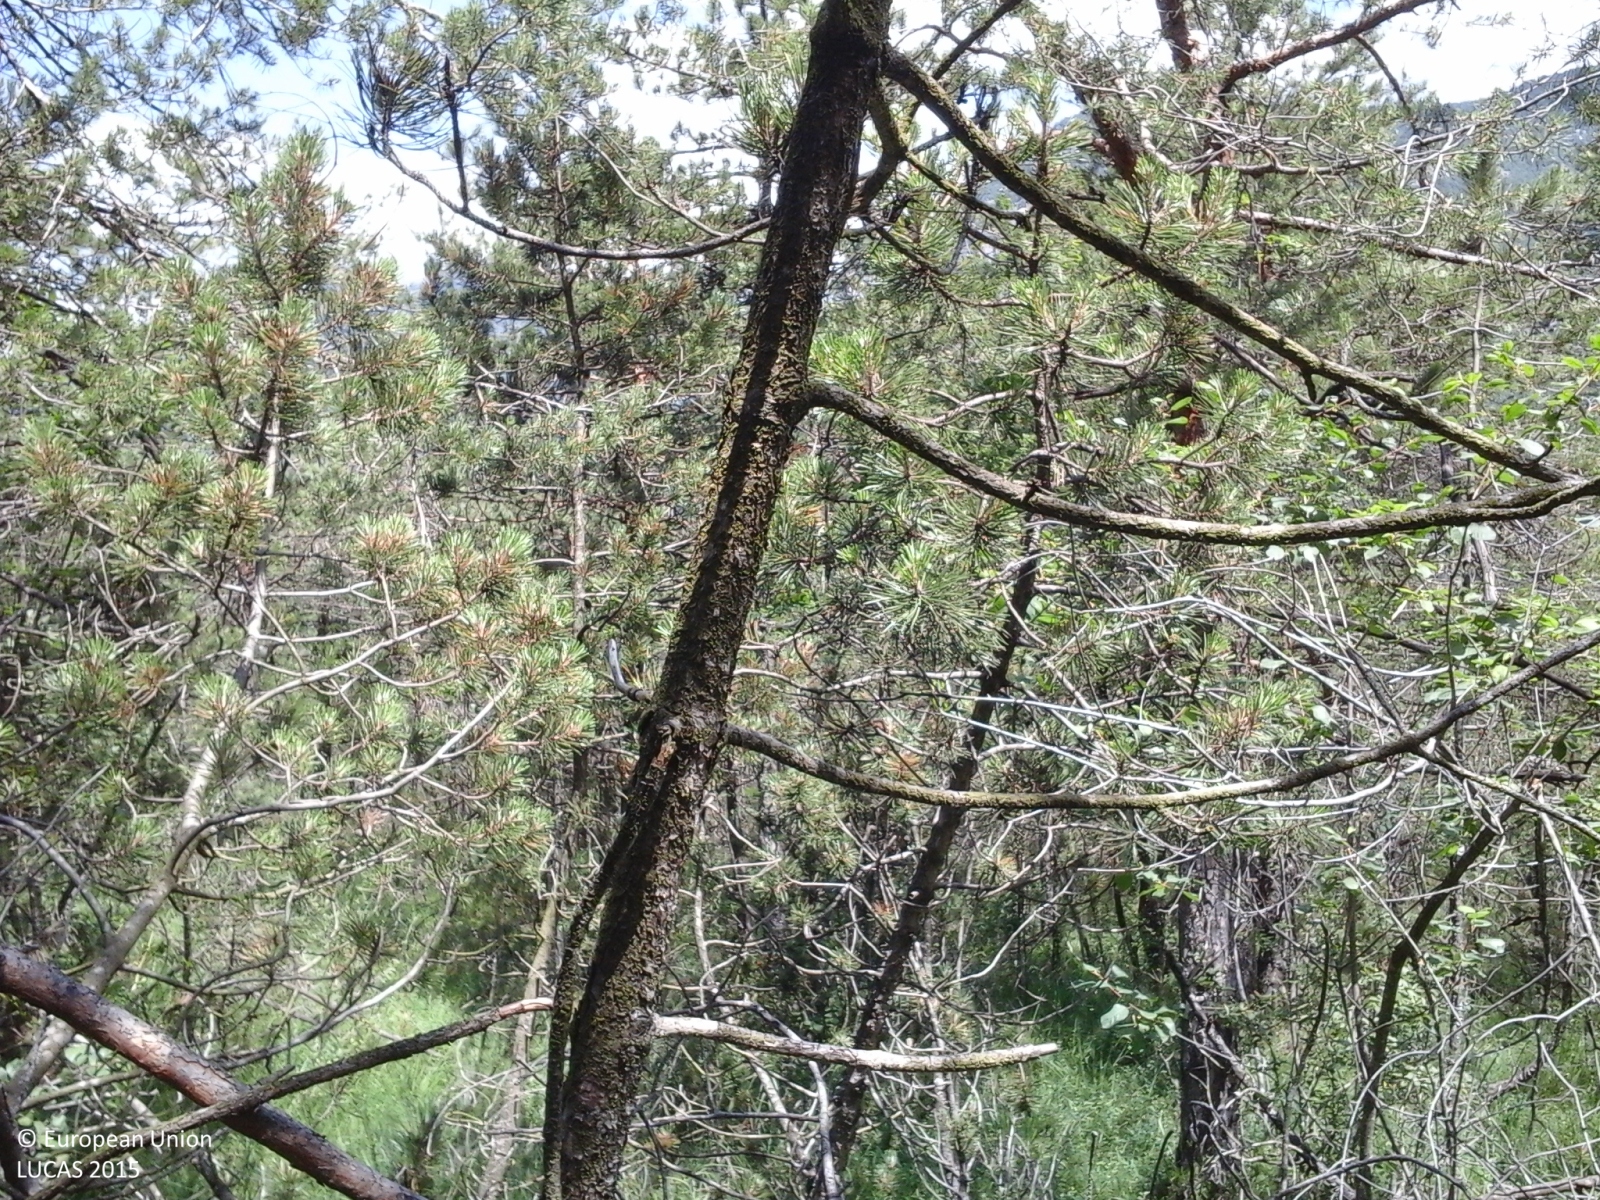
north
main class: Woodland
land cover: Pine dominated mixed woodland
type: alpine coniferous forest
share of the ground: > 75 %
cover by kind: coniferous forest trees 75 %, broadleaved forest trees 25 %
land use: Forestry
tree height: > 5 m
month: June
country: IT
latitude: 46.0339
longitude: 11.5354
